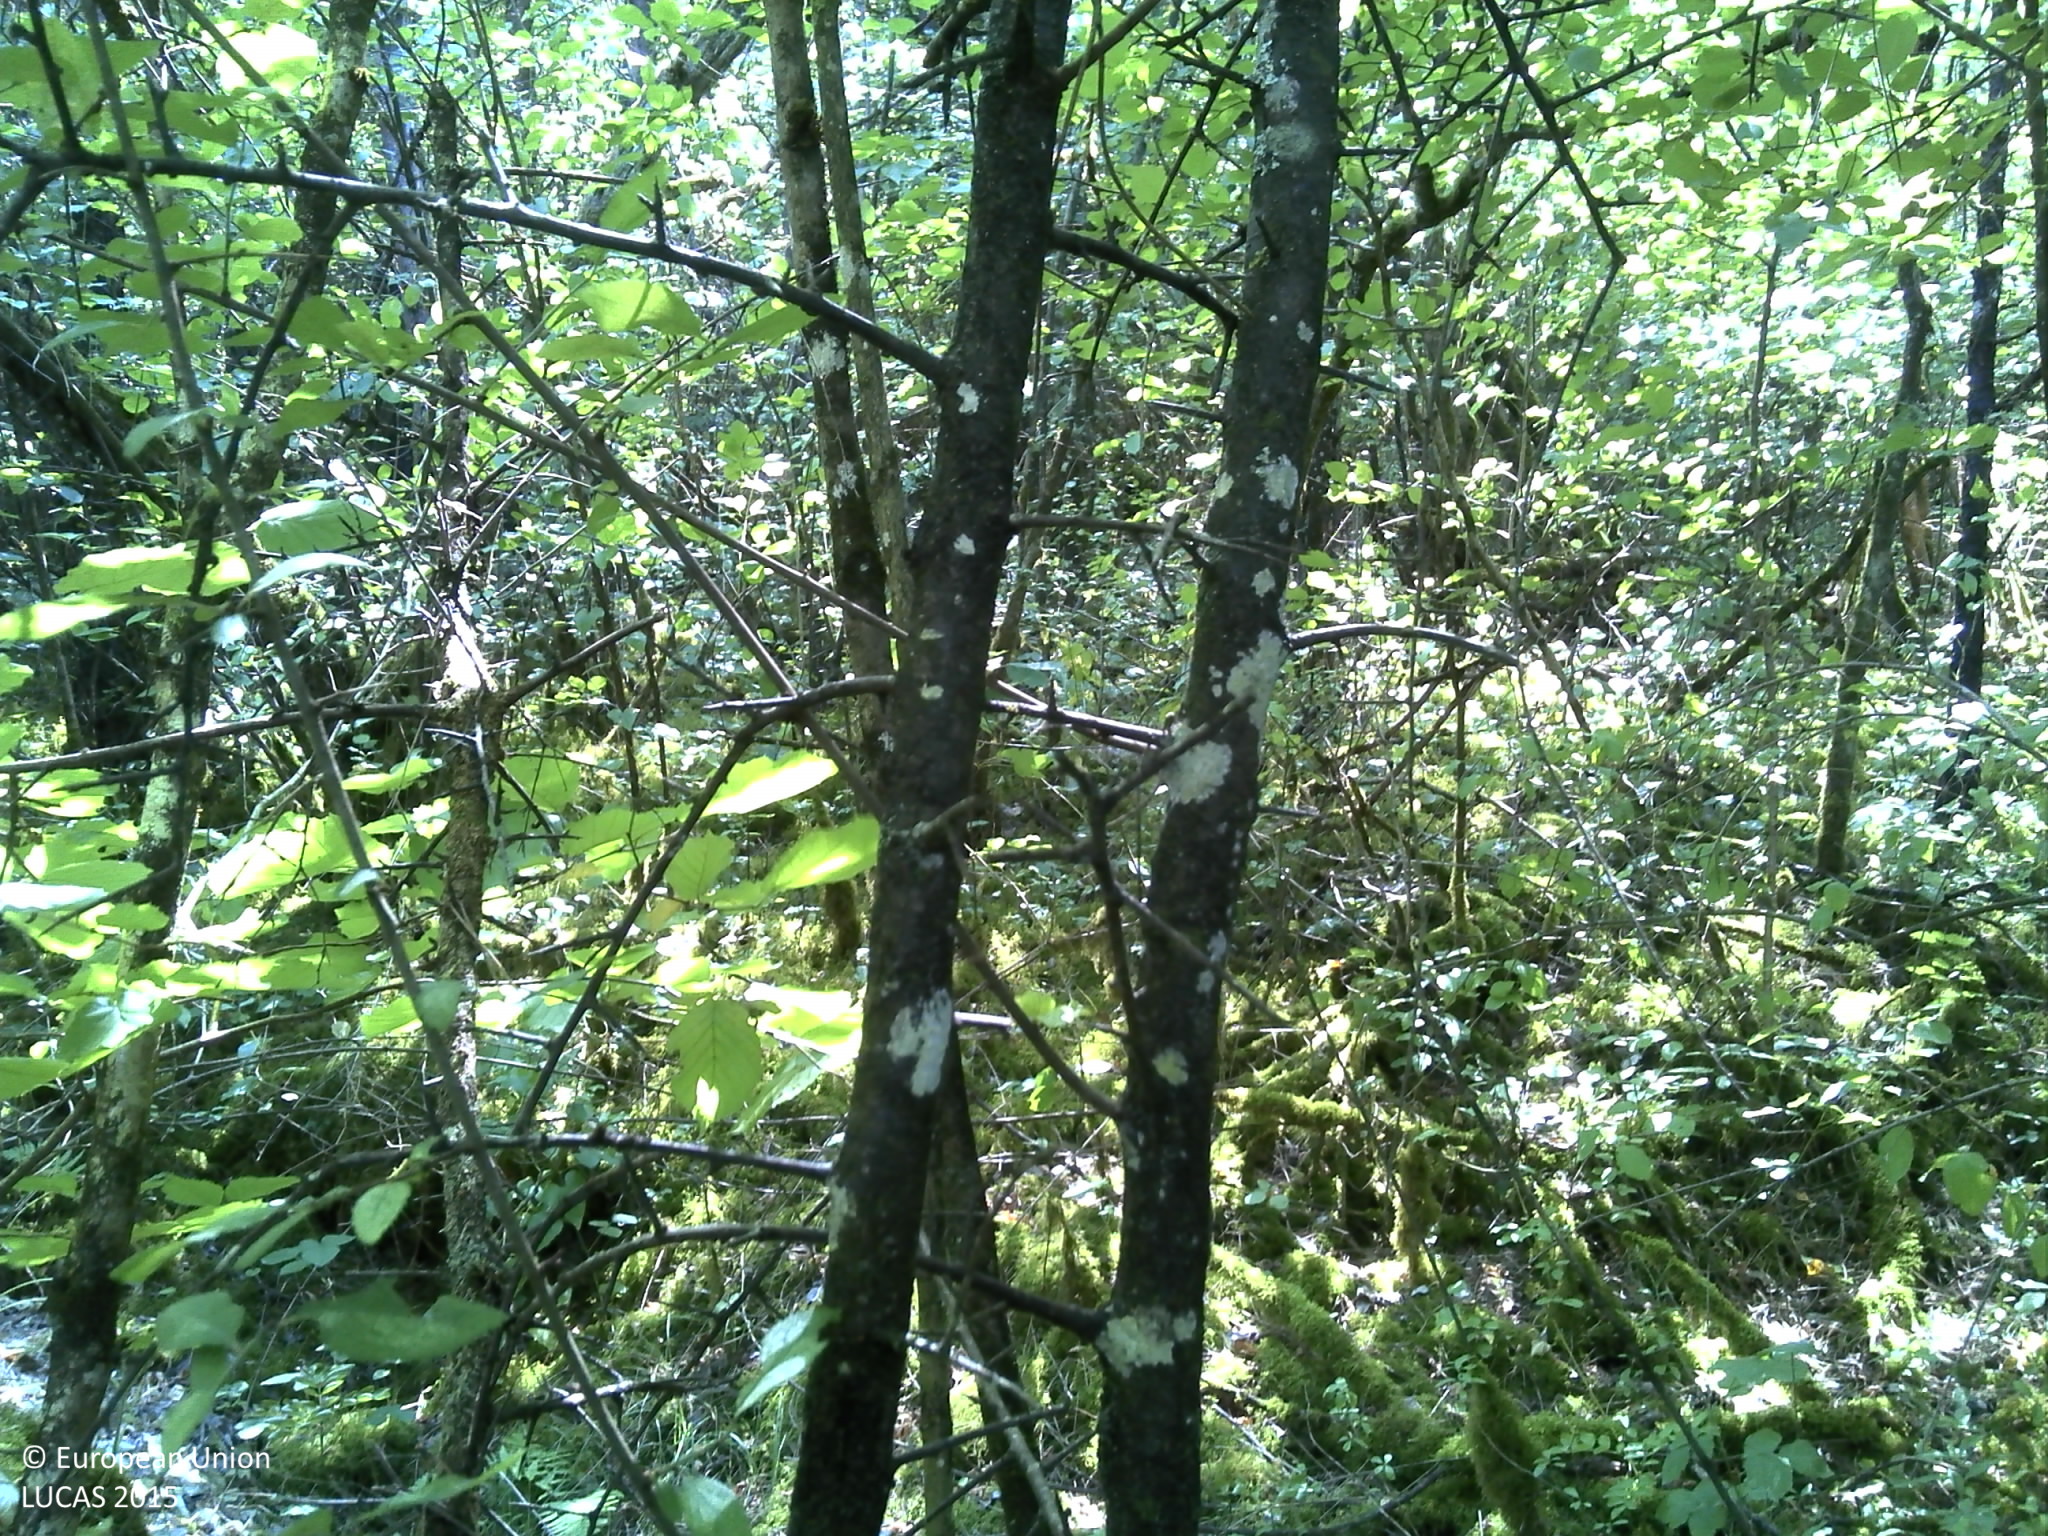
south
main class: Woodland
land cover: Broadleaved woodland
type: mesophytic deciduous forest
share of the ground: > 75 %
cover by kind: broadleaved forest trees 90 %, coniferous forest trees 5 %, herbaceous plants 5 %
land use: Semi-natural and natural areas not in use
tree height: > 5 m
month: August
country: FR
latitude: 48.9121
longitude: 4.7988
